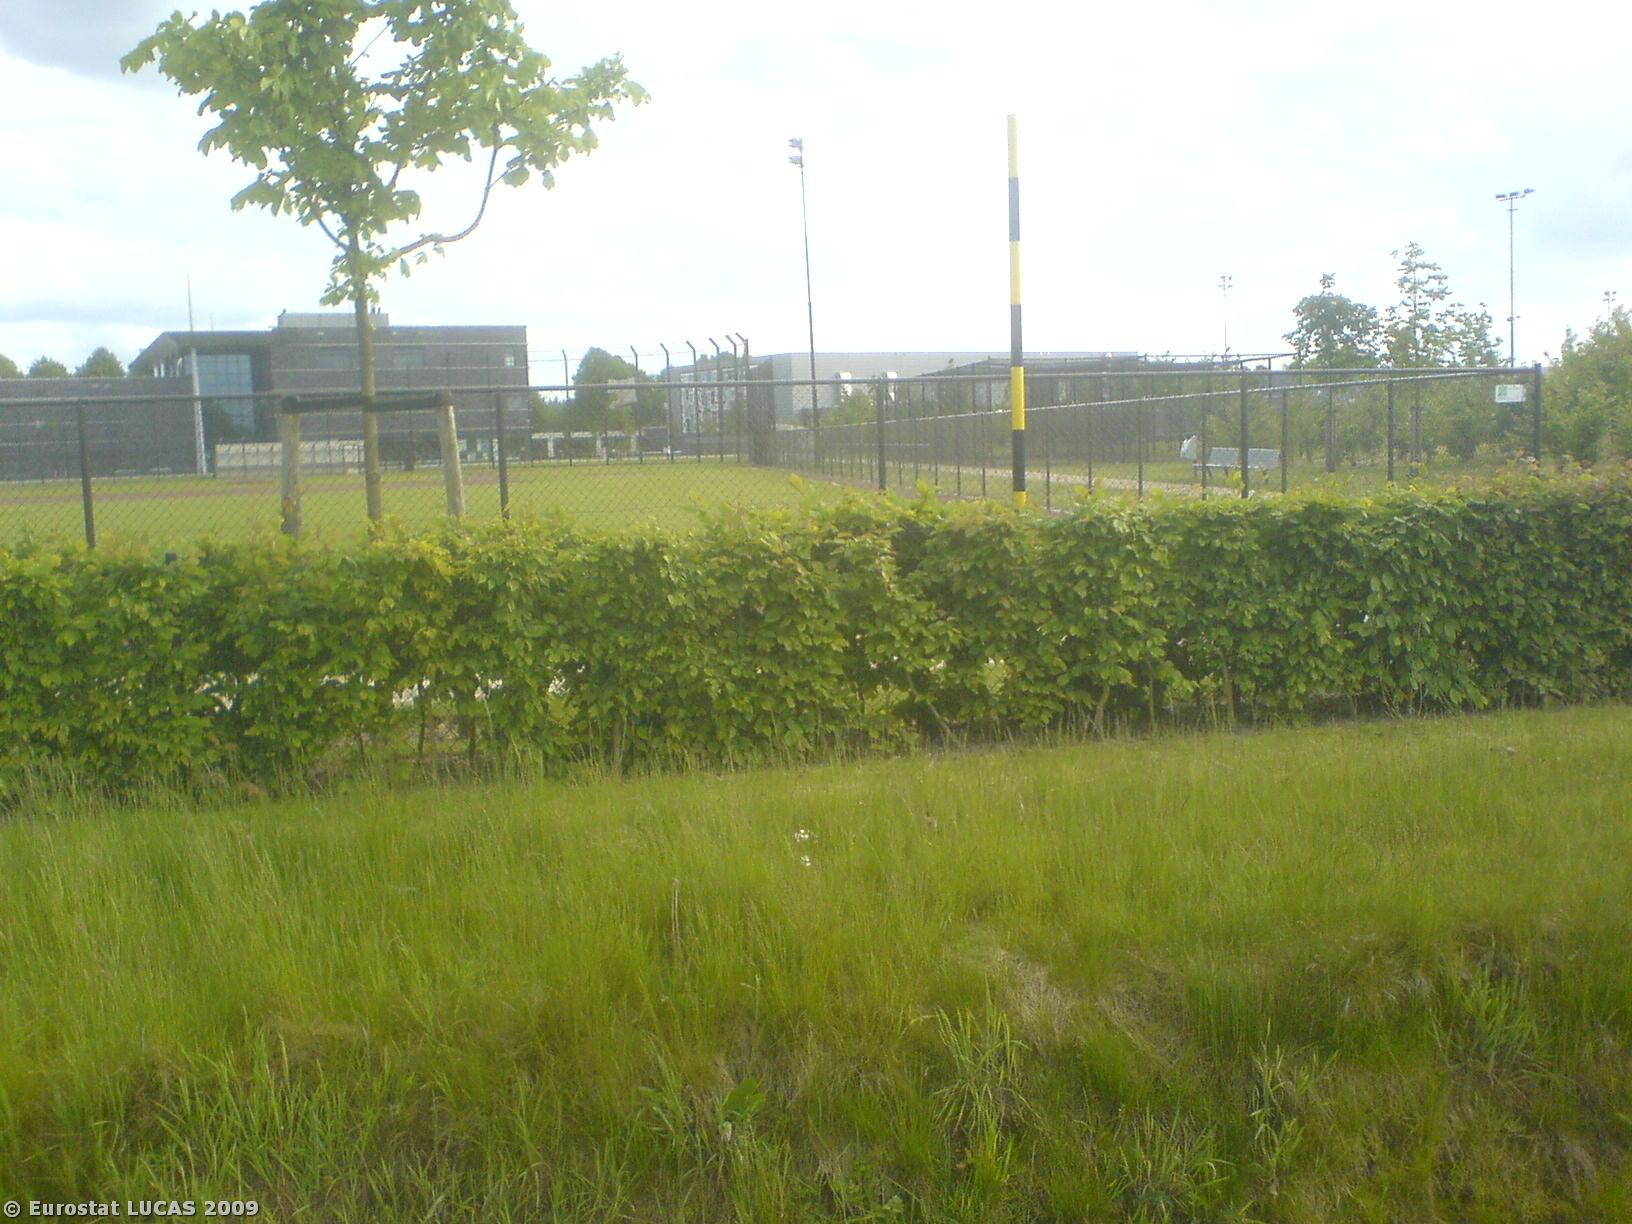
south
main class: Artificial land
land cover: Non built-up linear features
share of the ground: 10 - 25 %
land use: Road transport
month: May
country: NL
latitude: 51.4055
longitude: 5.3833
